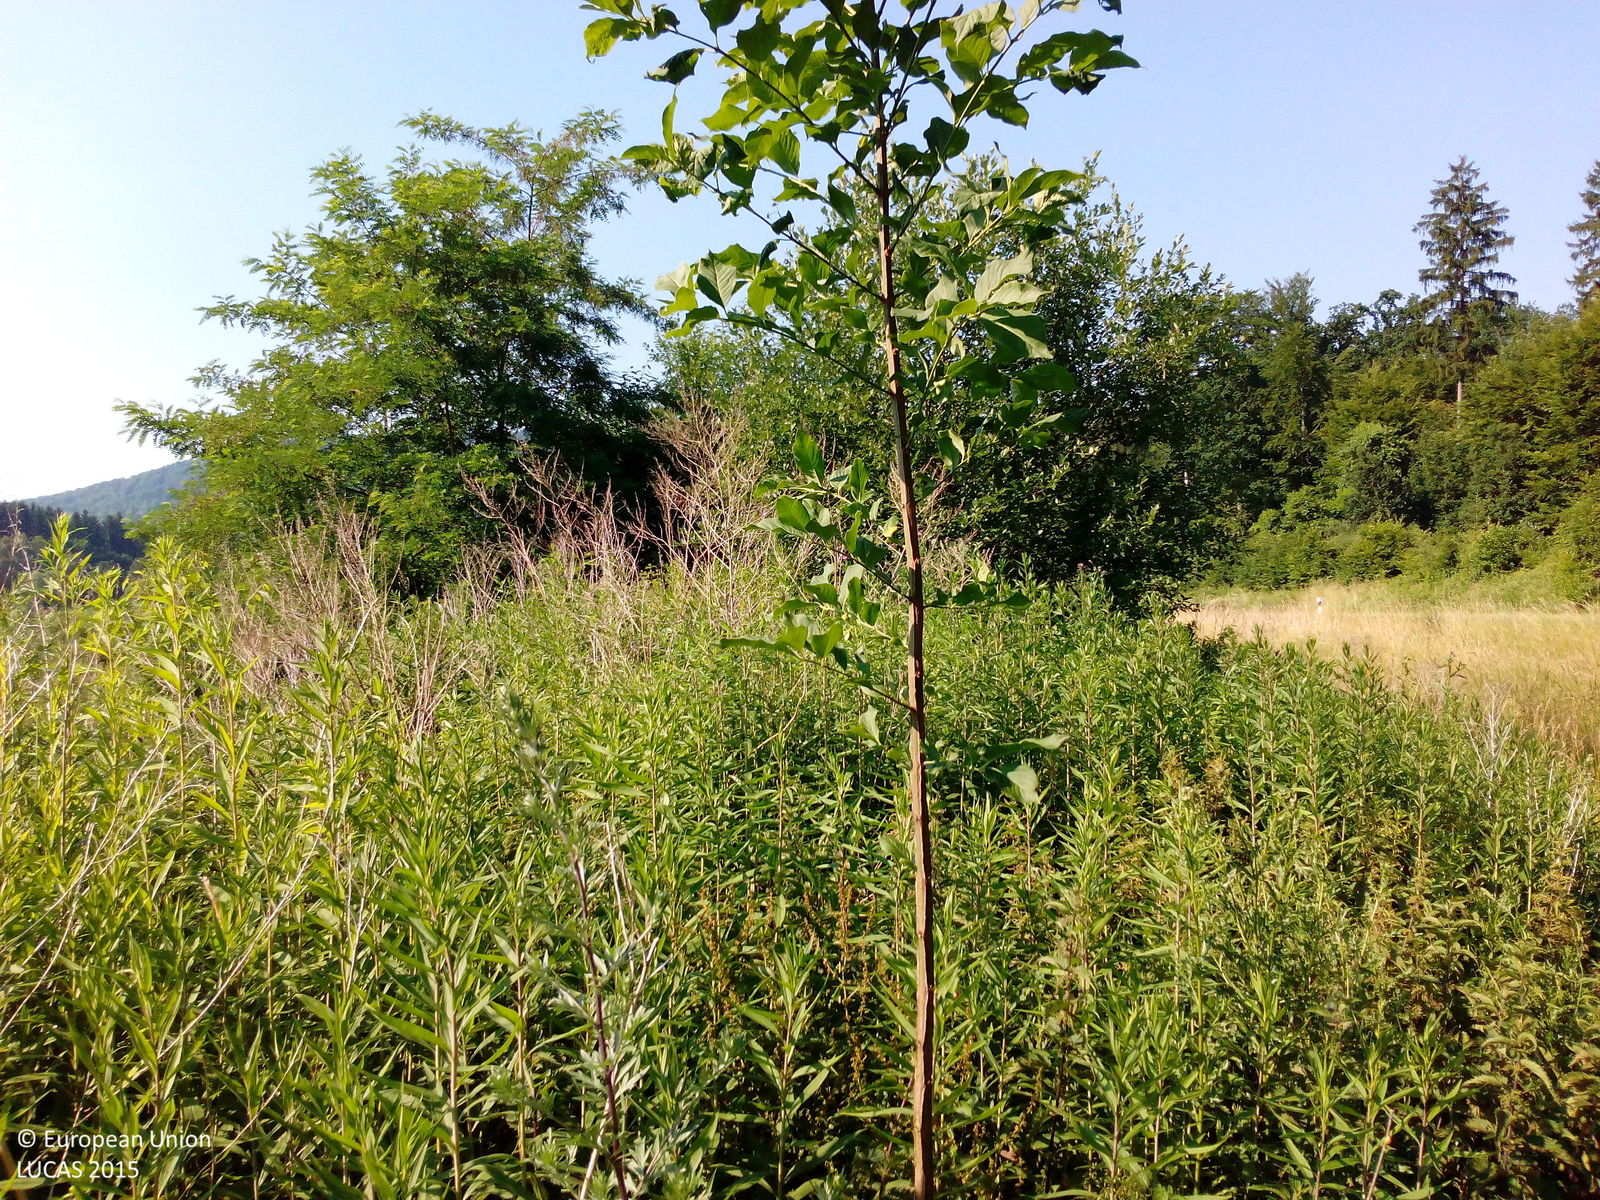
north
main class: Woodland
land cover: Broadleaved woodland
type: non-riverine alder, birch or aspen forest
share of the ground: > 75 %
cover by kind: broadleaved forest trees 75 %, herbaceous plants 15 %, shrubs 10 %
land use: Mining and quarrying
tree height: > 5 m
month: July
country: DE
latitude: 51.4602
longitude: 9.6403
